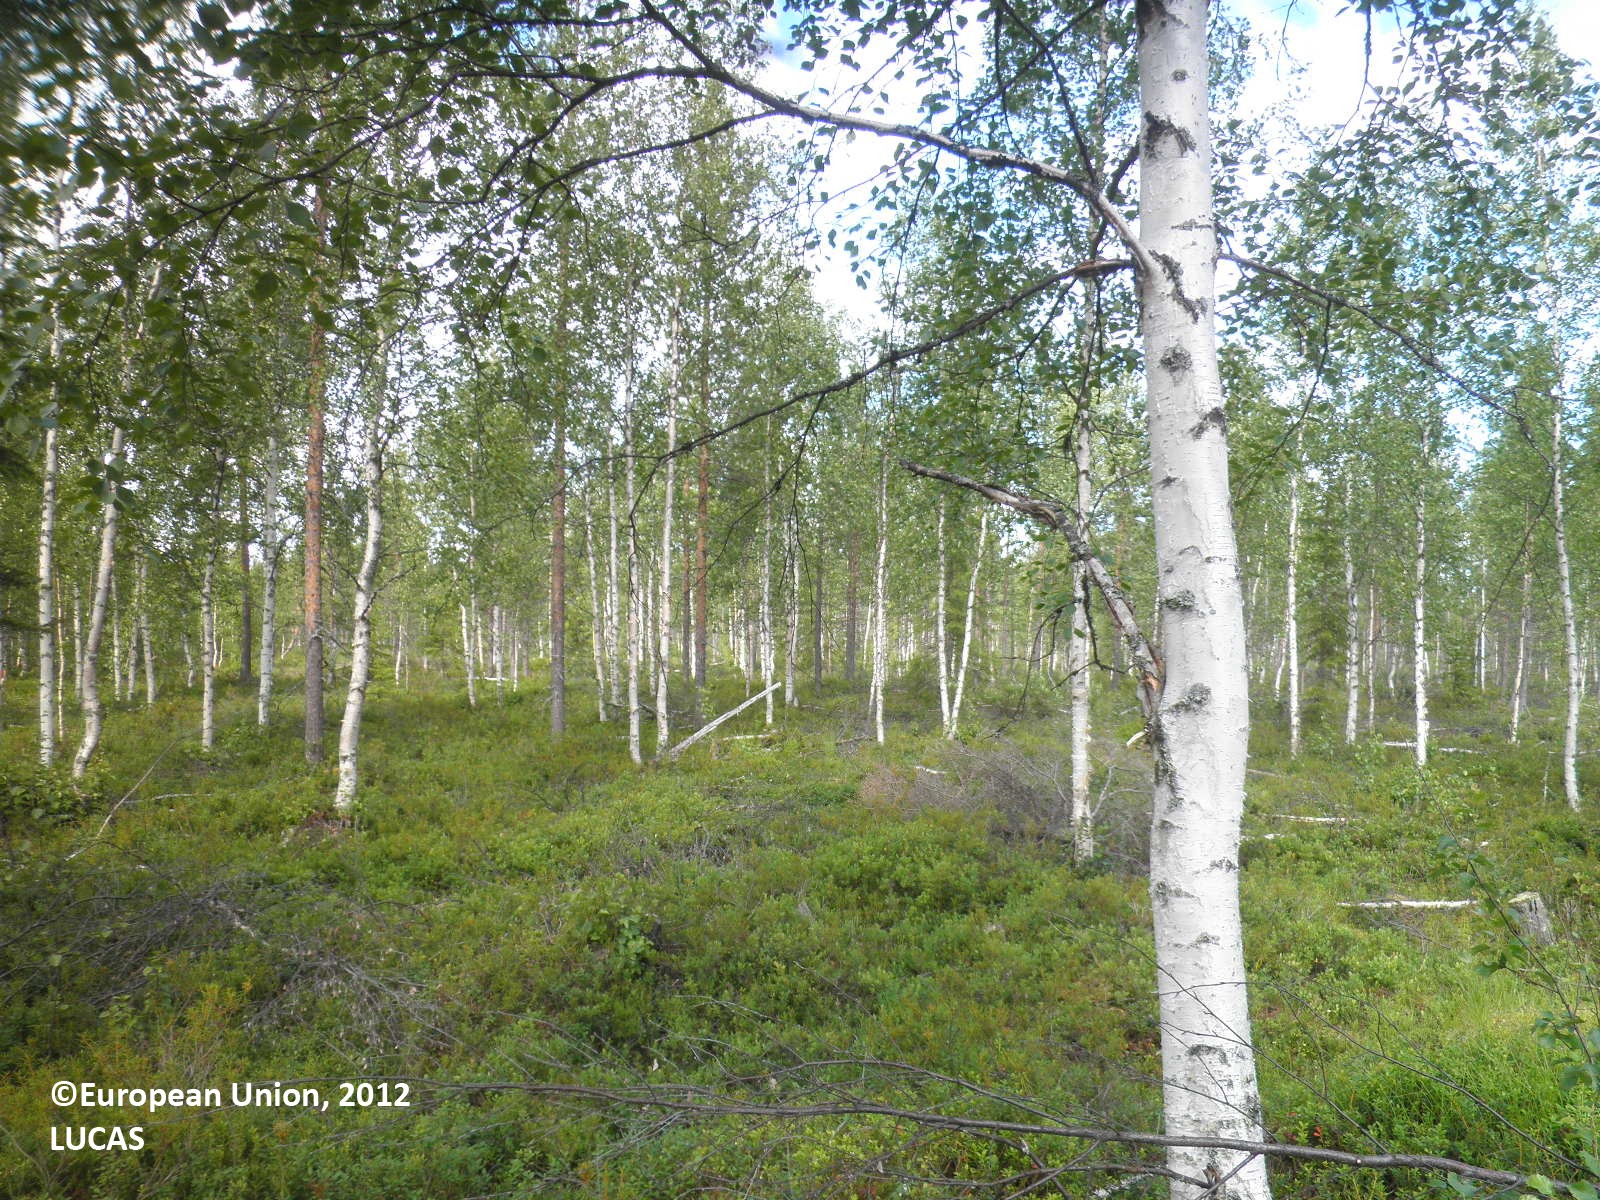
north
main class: Woodland
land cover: Pine dominated mixed woodland
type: boreal forest
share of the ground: 25 - 50 %
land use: Forestry
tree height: > 5 m
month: July
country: FI
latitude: 67.4515
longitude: 26.8359
